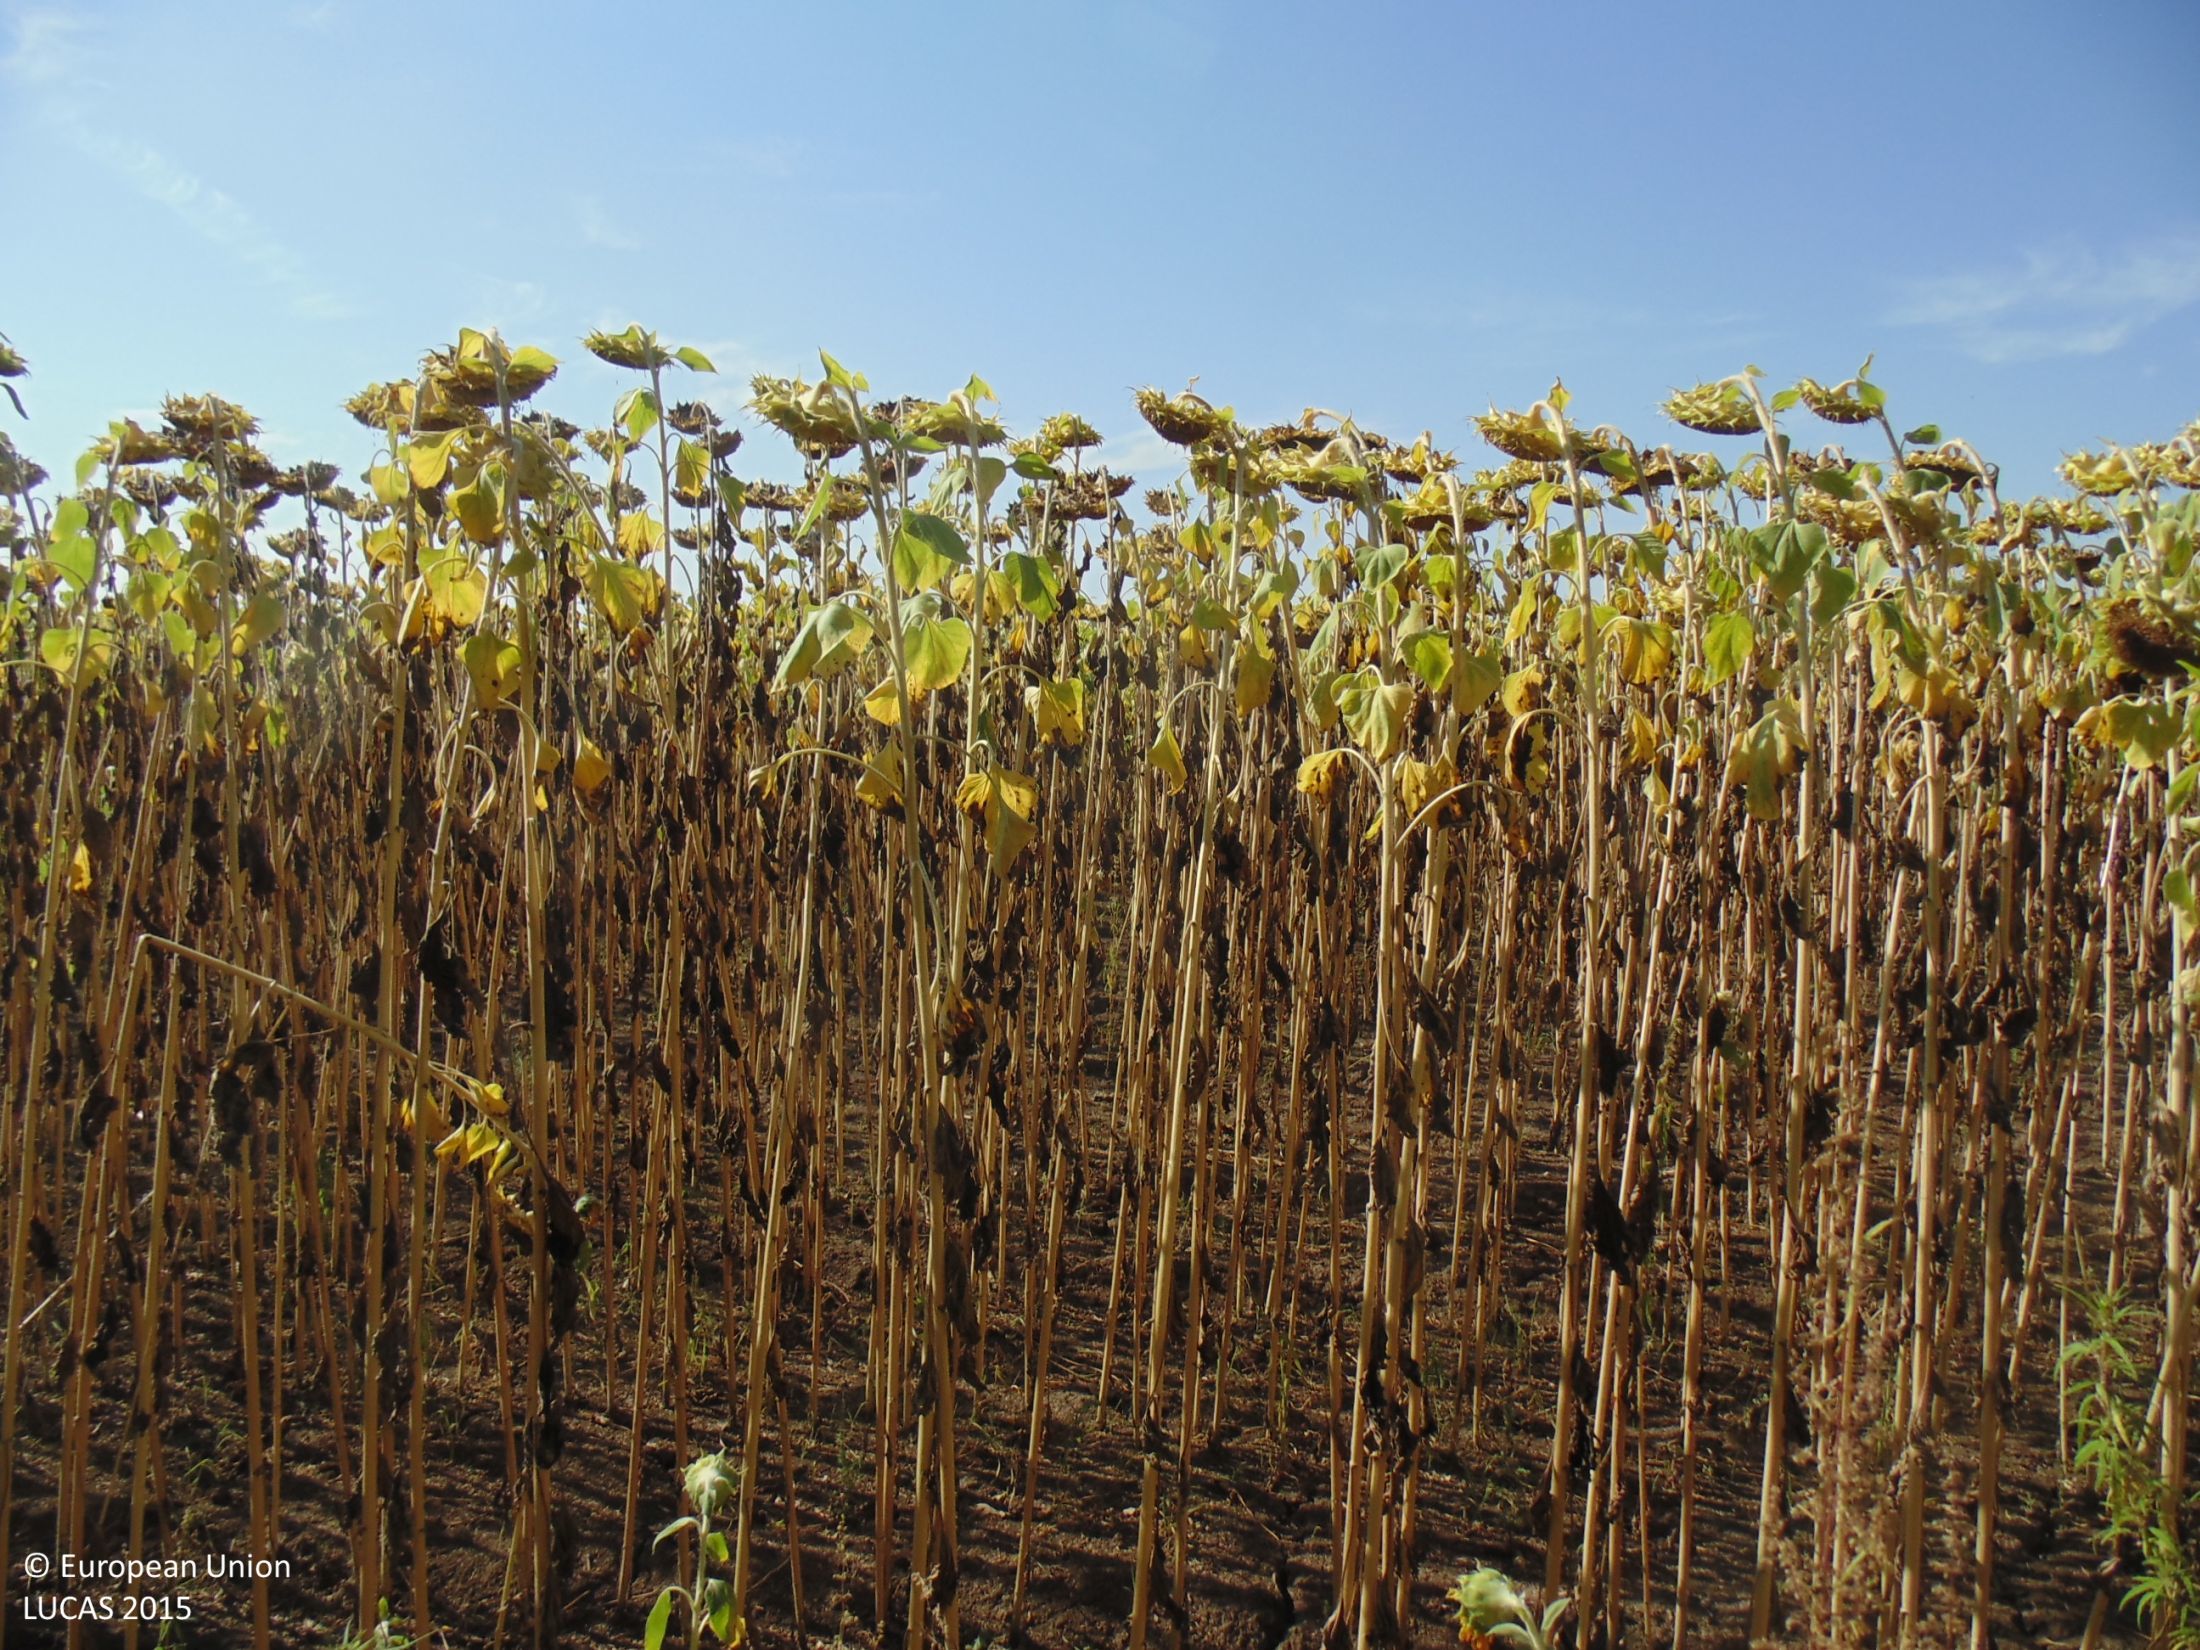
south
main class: Woodland
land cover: Broadleaved woodland
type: mesophytic deciduous forest
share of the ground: > 75 %
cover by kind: broadleaved forest trees 80 %, shrubs 10 %, herbaceous plants 10 %
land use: Forestry
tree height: > 5 m
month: August
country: BG
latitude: 43.6484
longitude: 28.1923
